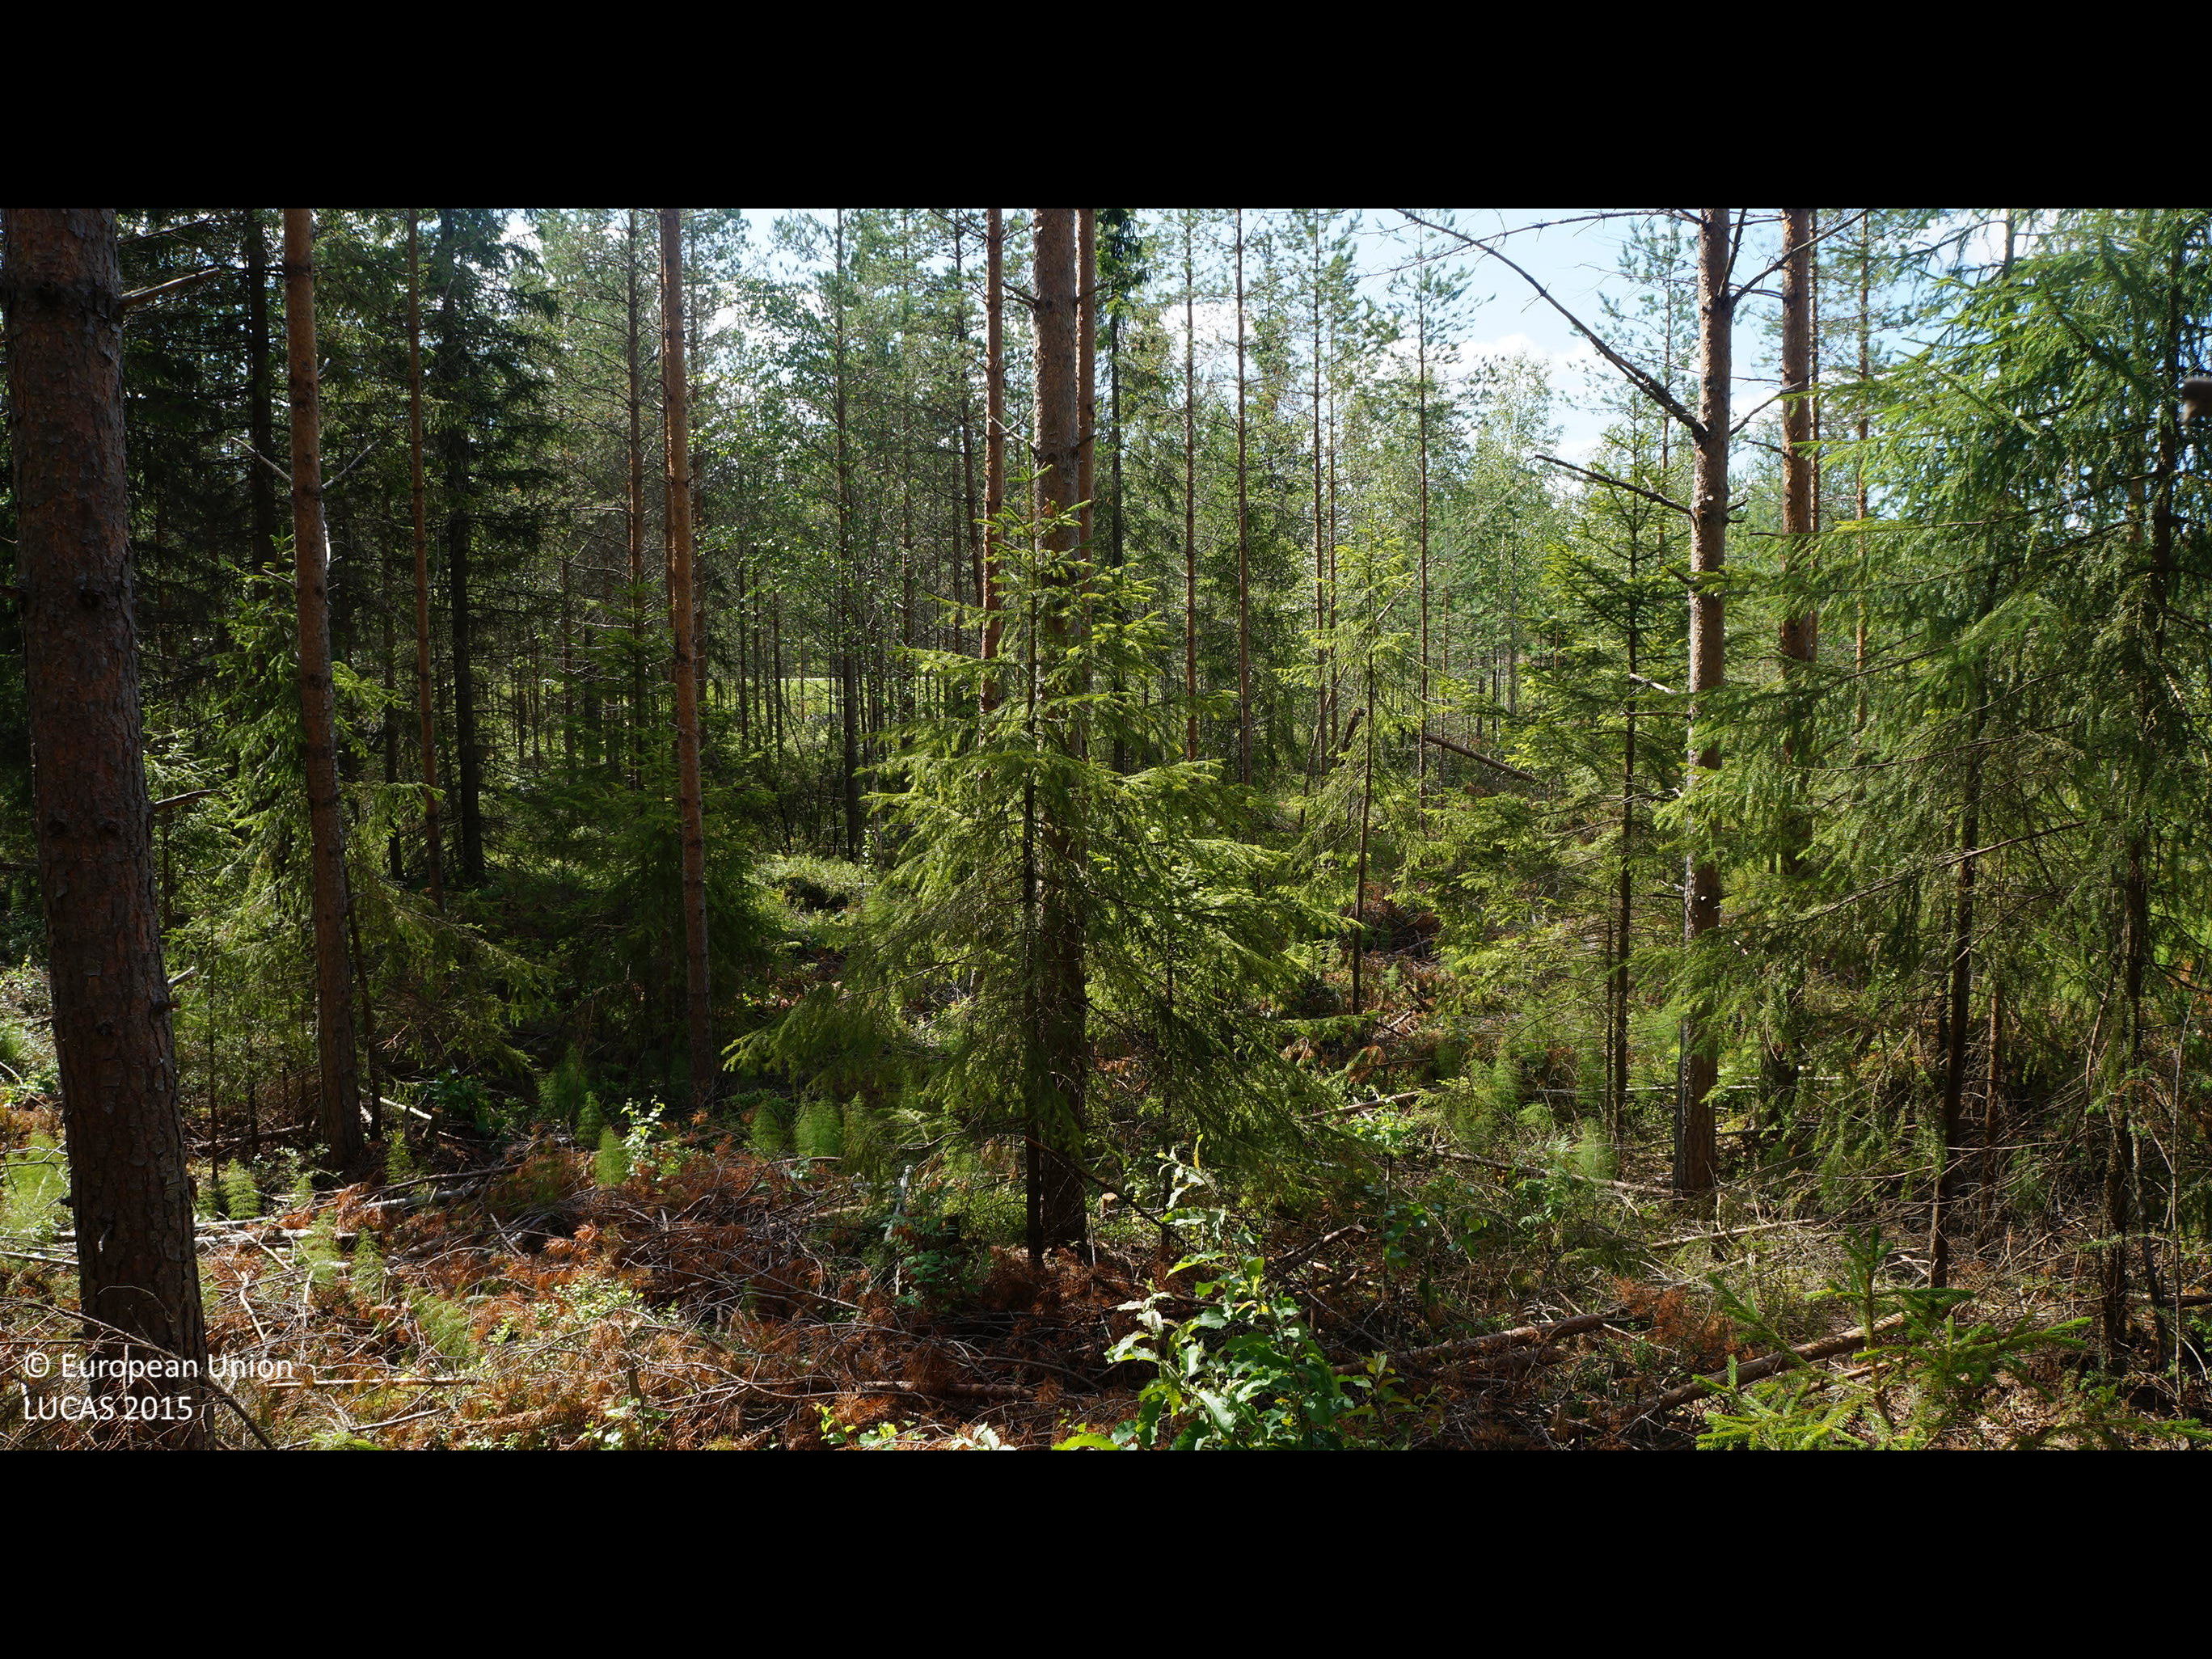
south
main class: Woodland
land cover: Other coniferous woodland
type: boreal forest
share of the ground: 50 - 75 %
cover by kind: coniferous forest trees 55 %, shrubs 30 %, lichens and mosses 10 %
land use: Forestry
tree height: > 5 m
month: July
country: FI
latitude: 63.9241
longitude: 24.3667
